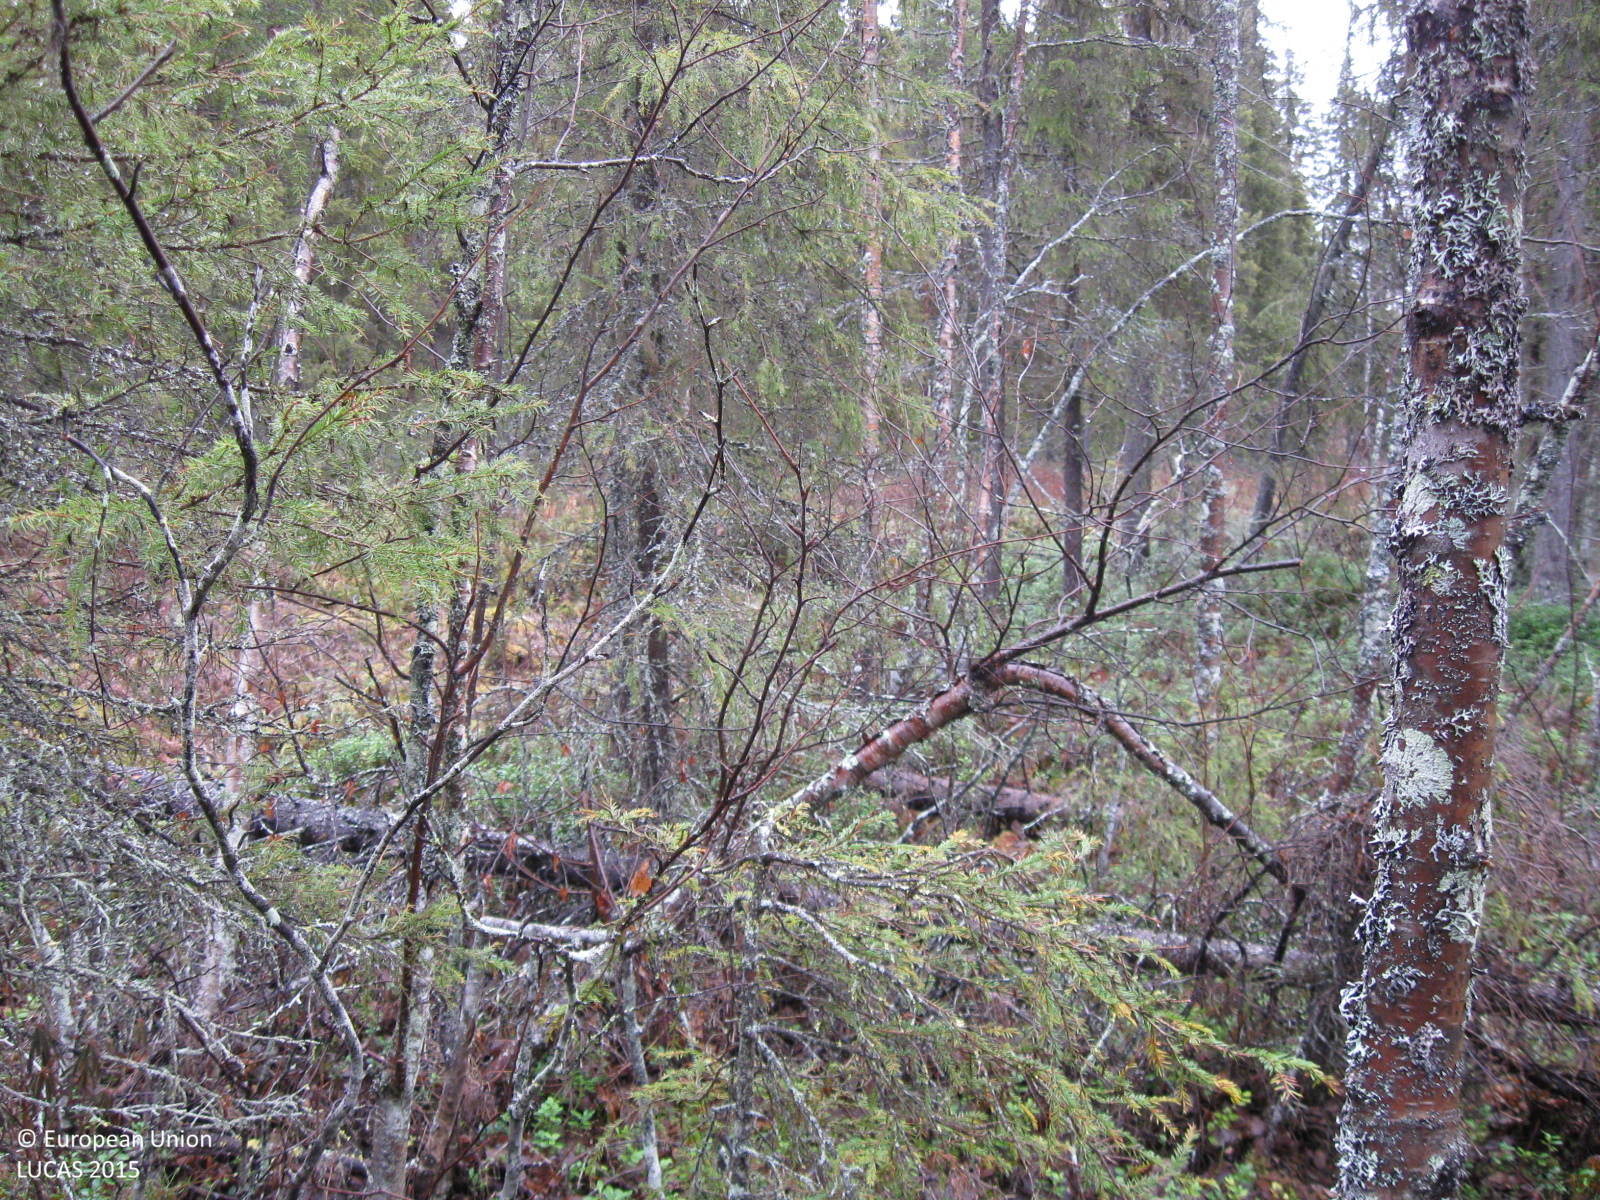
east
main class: Woodland
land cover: Spruce dominated mixed woodland
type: boreal forest
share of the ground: > 75 %
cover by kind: coniferous forest trees 50 %, broadleaved forest trees 30 %, shrubs 10 %, herbaceous plants 5 %, lichens and mosses 5 %
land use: Forestry
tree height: > 5 m
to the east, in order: Spruce dominated mixed woodland; Shrubland with sparse tree cover; Electric lines; Shrubland with sparse tree cover; Spruce dominated mixed woodland; Spruce dominated coniferous woodland; Spruce dominated mixed woodland; Rivers and streams; Spruce dominated mixed woodland; Broadleaved woodland; Grassland with sparse tree/shrub cover; Paved roads, cycling and walking lanes
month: October
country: SE
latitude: 66.7548
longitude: 21.0596
